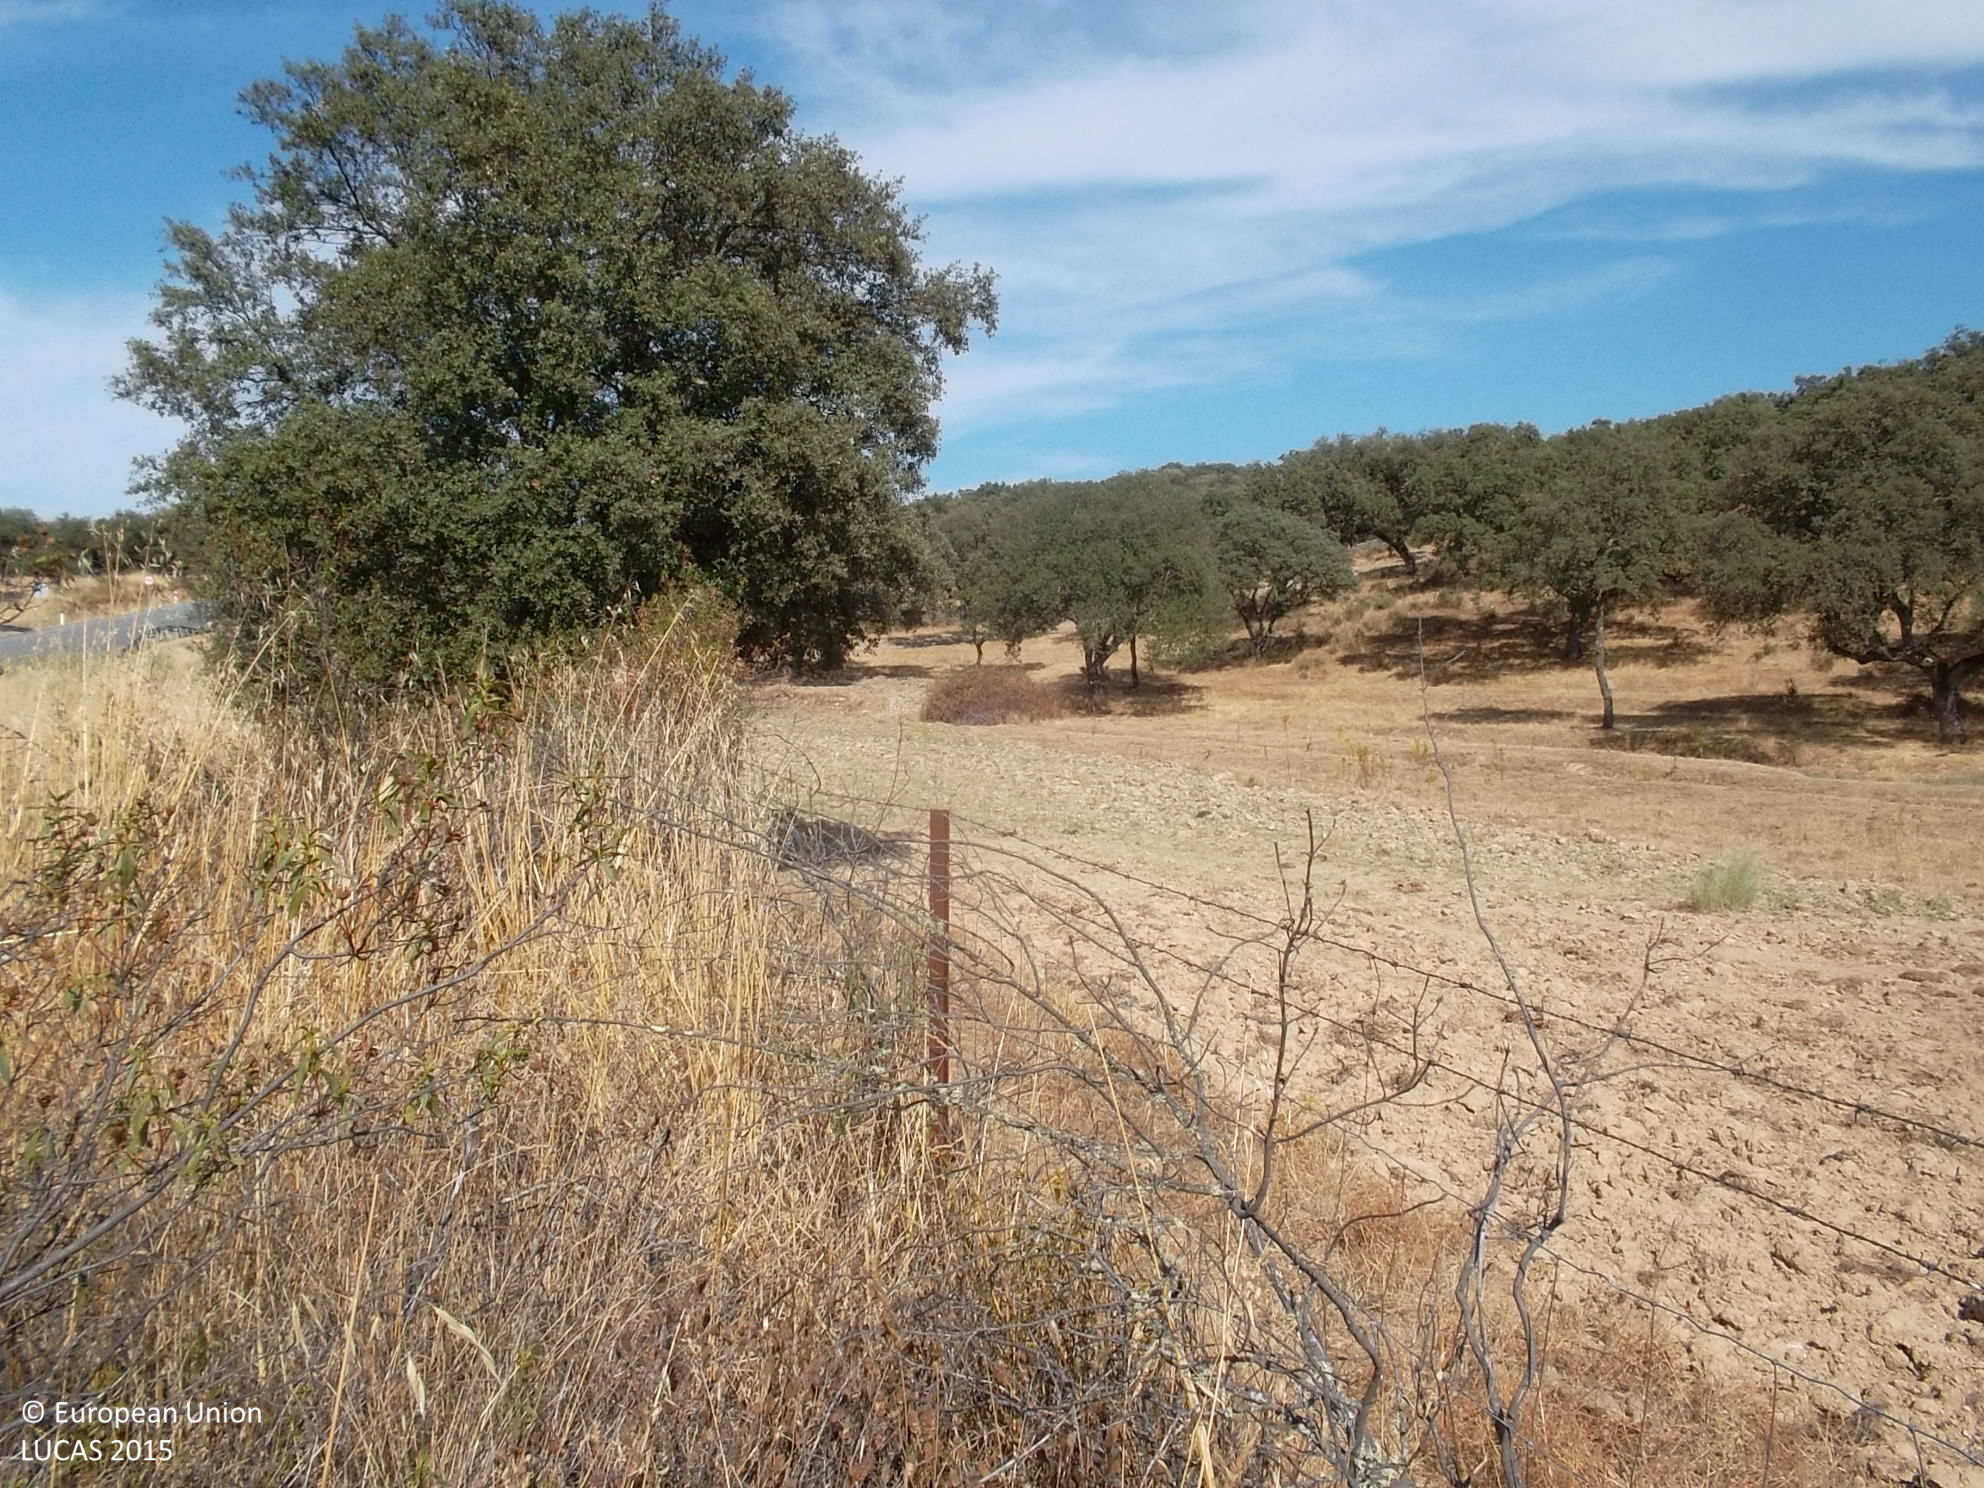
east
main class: Woodland
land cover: Broadleaved woodland
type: broadleaved evergreen forest
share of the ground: 50 - 75 %
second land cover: Grassland without tree/shrub cover
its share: > 75 %
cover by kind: broadleaved forest trees 50 %, herbaceous plants 50 %
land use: Forestry
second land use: Agriculture (excluding fallow land and kitchen gardens)
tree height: > 5 m
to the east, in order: Broadleaved woodland; Grassland without tree/shrub cover; Broadleaved woodland; Rivers and streams; Broadleaved woodland; Dry stone walls
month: August
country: ES
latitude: 38.1581
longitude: -6.8184
